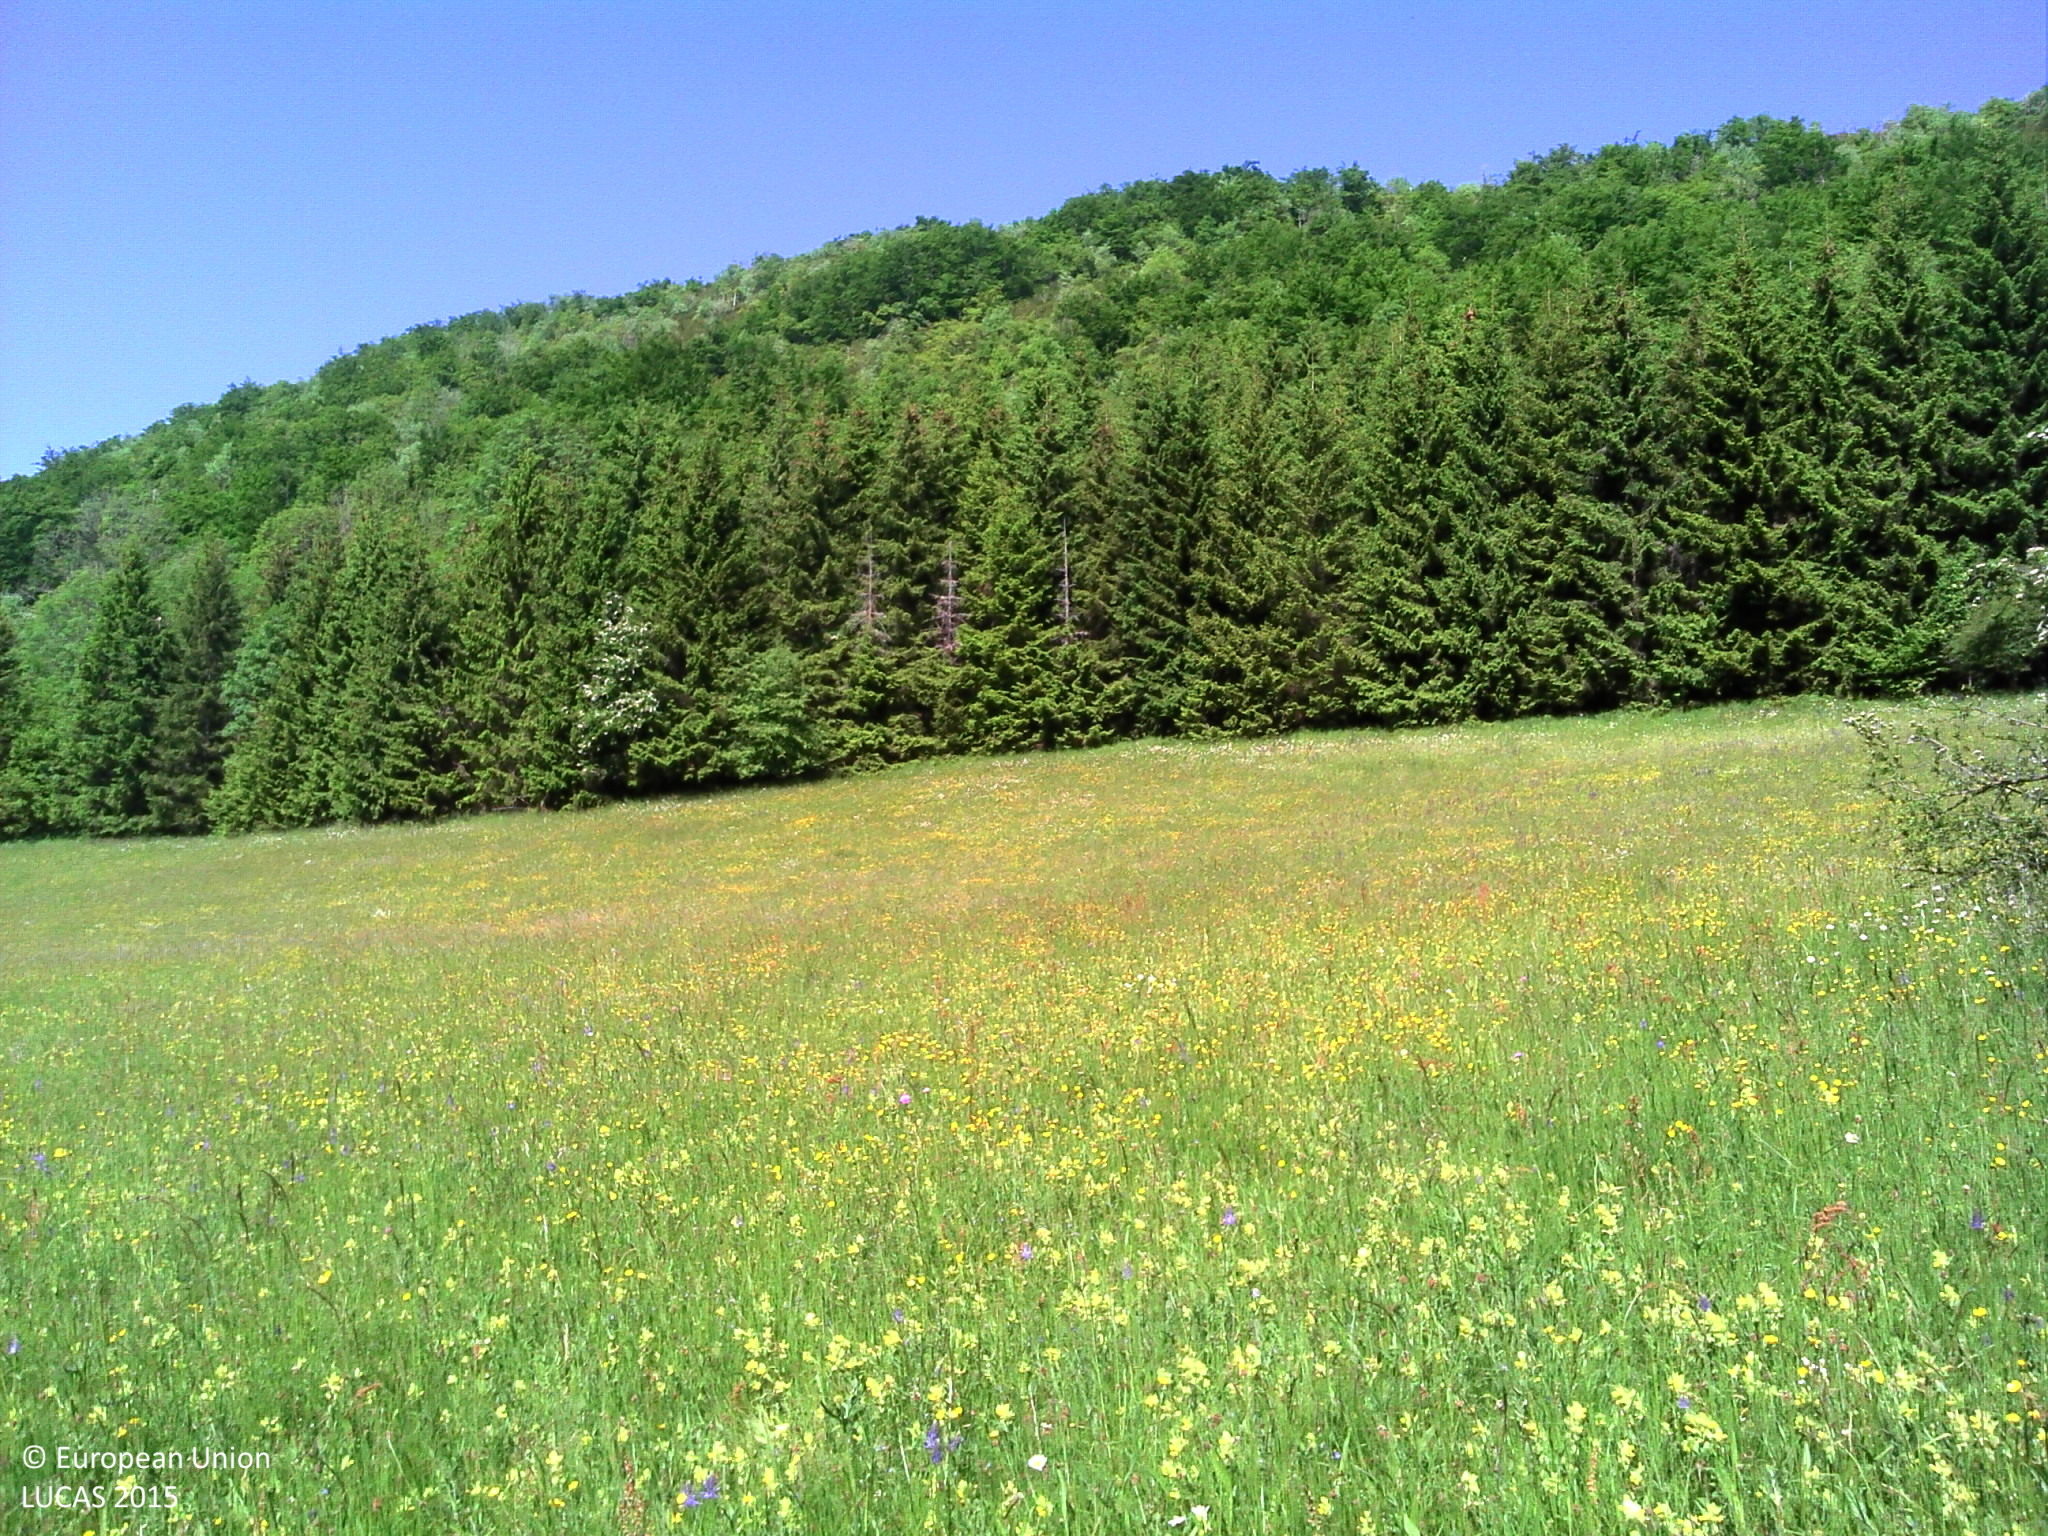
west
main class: Grassland
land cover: Grassland without tree/shrub cover
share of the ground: > 75 %
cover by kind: herbaceous plants 100 %
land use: Agriculture (excluding fallow land and kitchen gardens)
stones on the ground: < 10 %
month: June
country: FR
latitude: 44.9811
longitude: 5.2248
